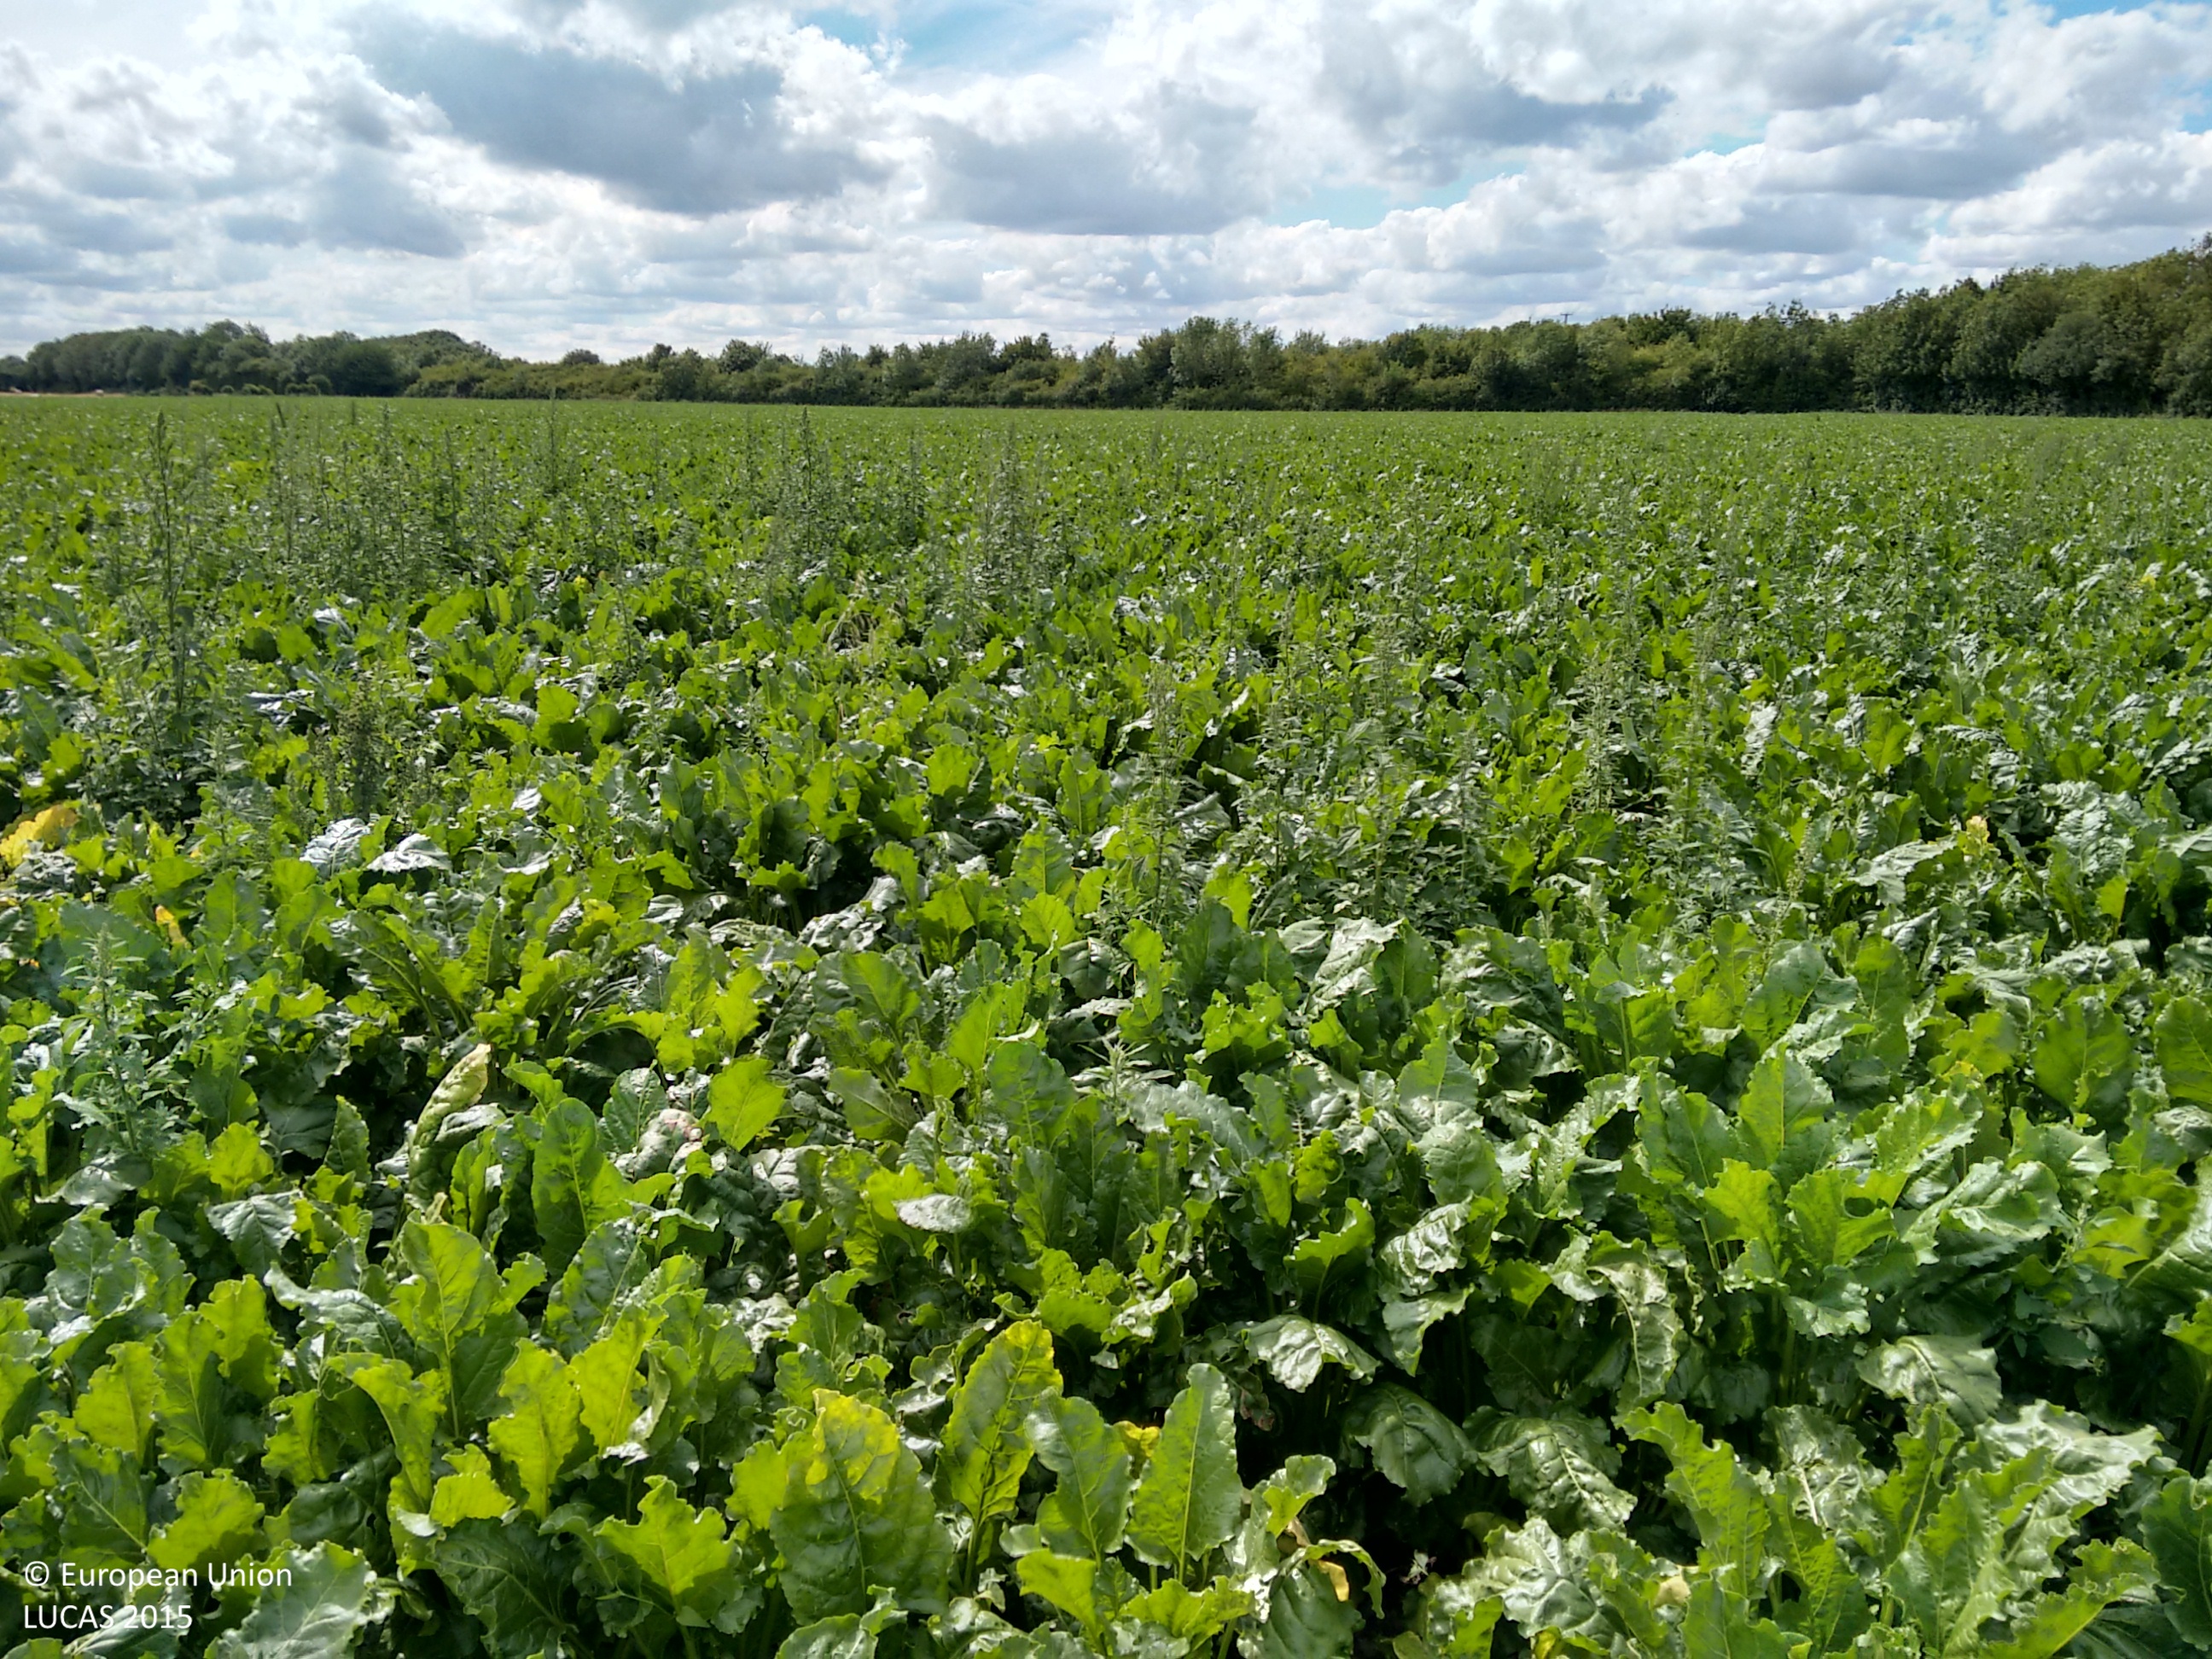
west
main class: Cropland
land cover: Sugar beet
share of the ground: > 75 %
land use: Agriculture (excluding fallow land and kitchen gardens)
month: August
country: GB
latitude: 52.4849
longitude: 0.5039
